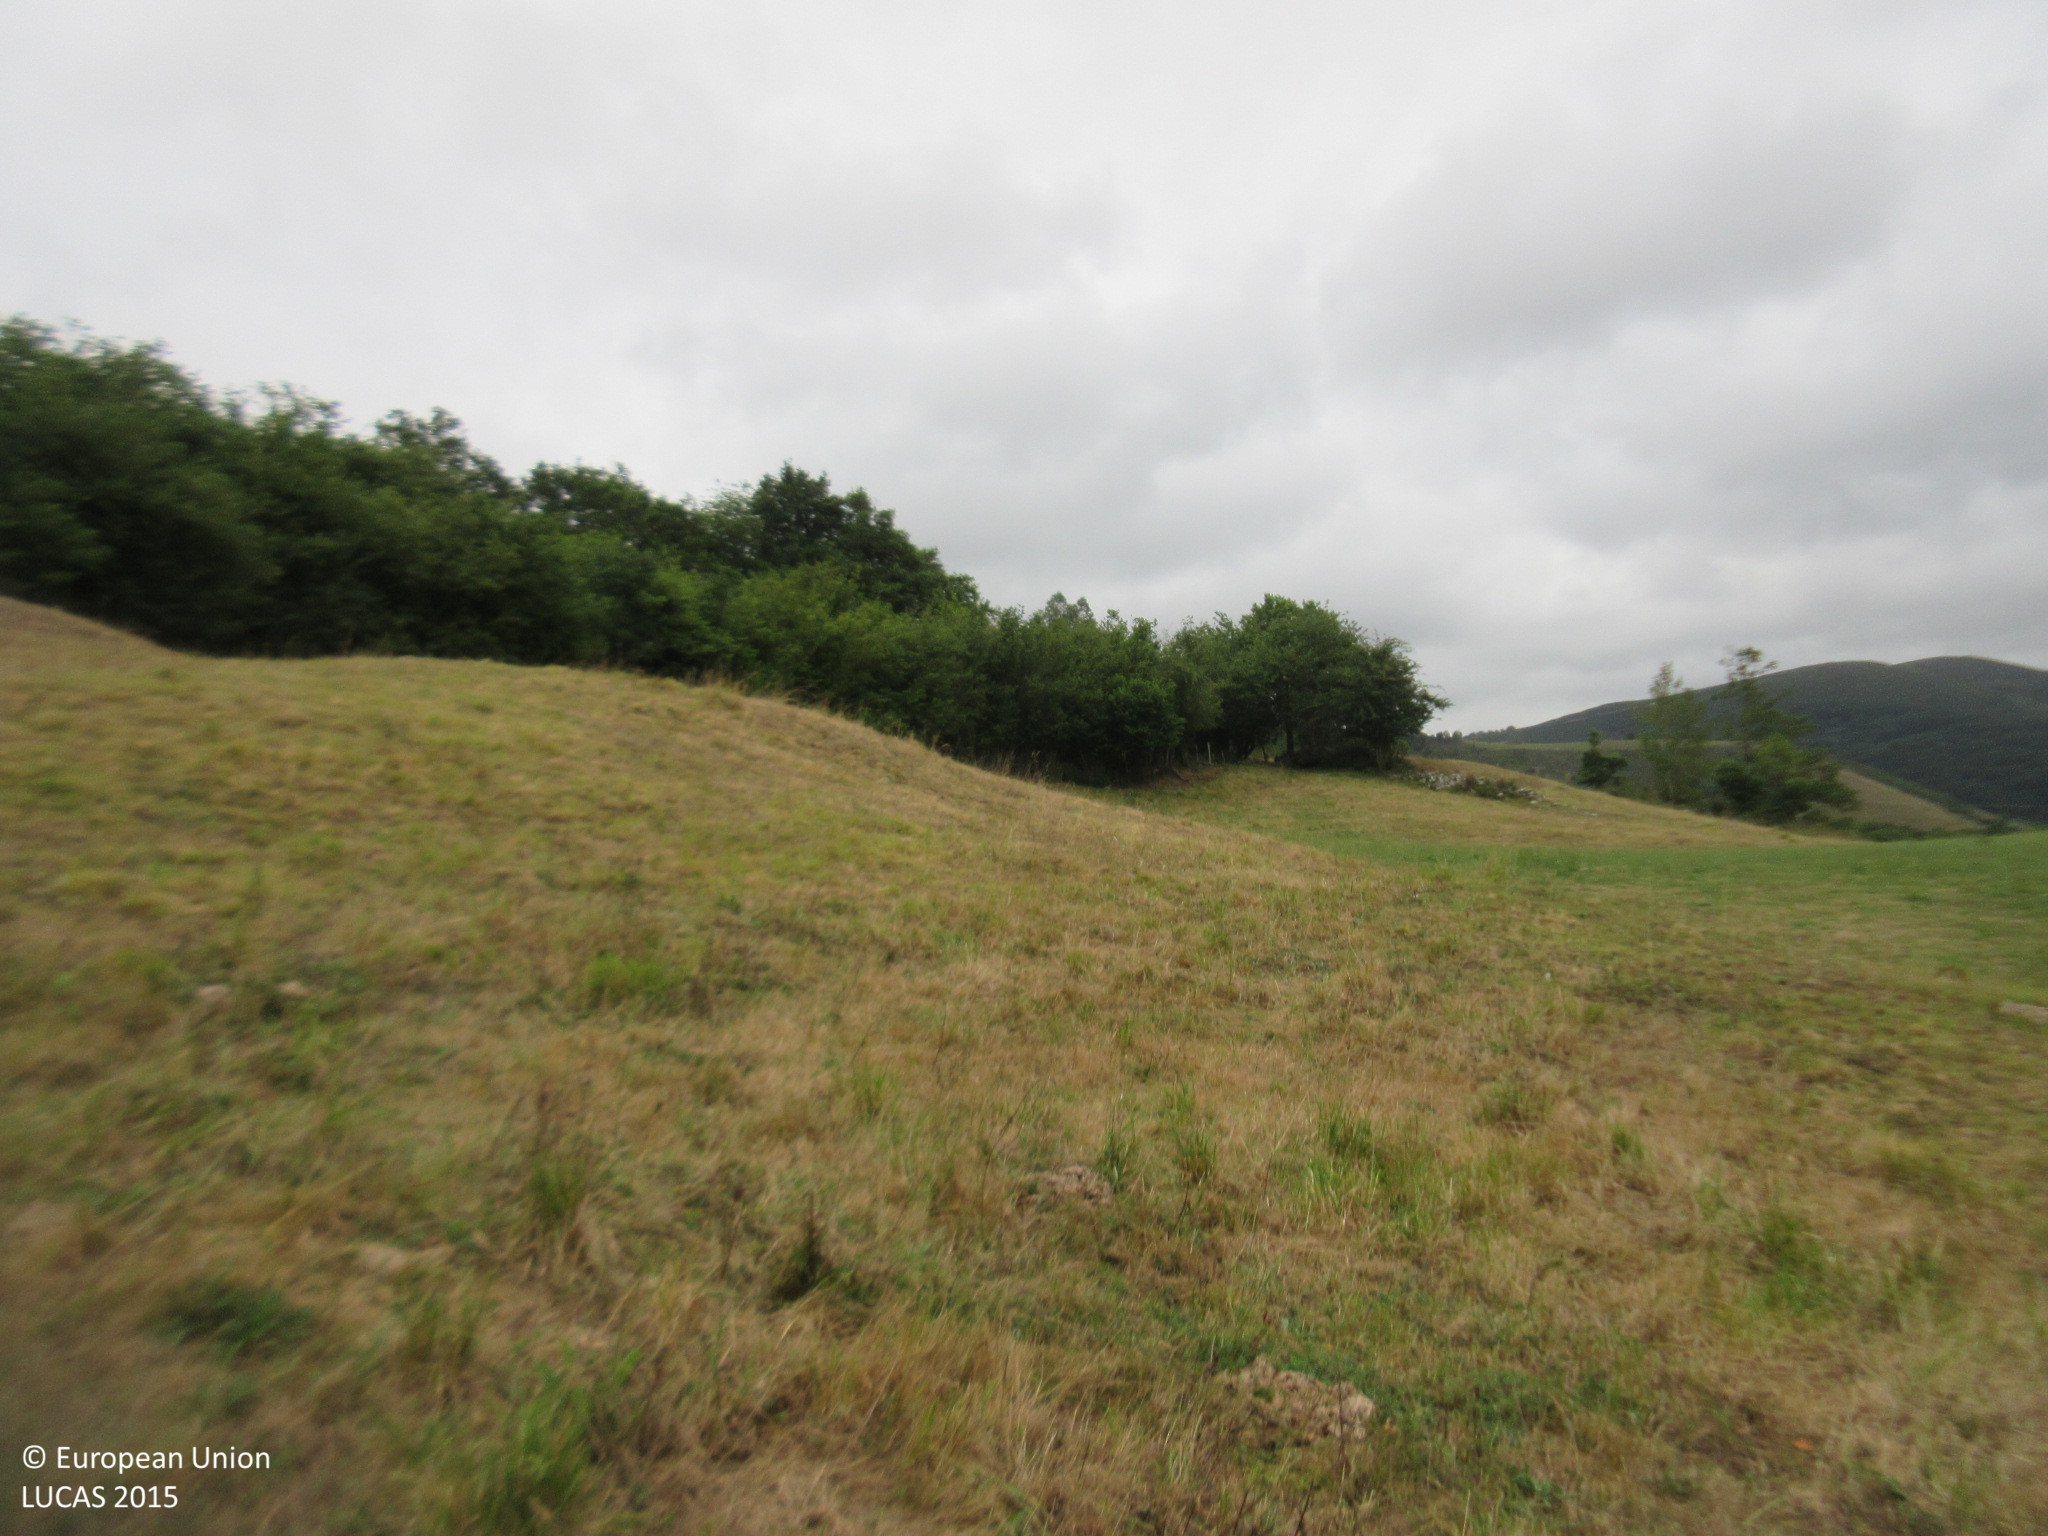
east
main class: Grassland
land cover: Grassland without tree/shrub cover
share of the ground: > 75 %
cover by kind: herbaceous plants 100 %
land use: Agriculture (excluding fallow land and kitchen gardens)
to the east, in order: Grassland without tree/shrub cover; Dry stone walls; Abandoned hedges; Tracks; Dry stone walls; Abandoned hedges; Grassland without tree/shrub cover; Dry stone walls; Abandoned hedges; Tracks; Dry stone walls; Abandoned hedges; Grassland without tree/shrub cover; Fences; Shruby margins; Tracks
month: July
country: ES
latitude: 43.2136
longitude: -3.9965
